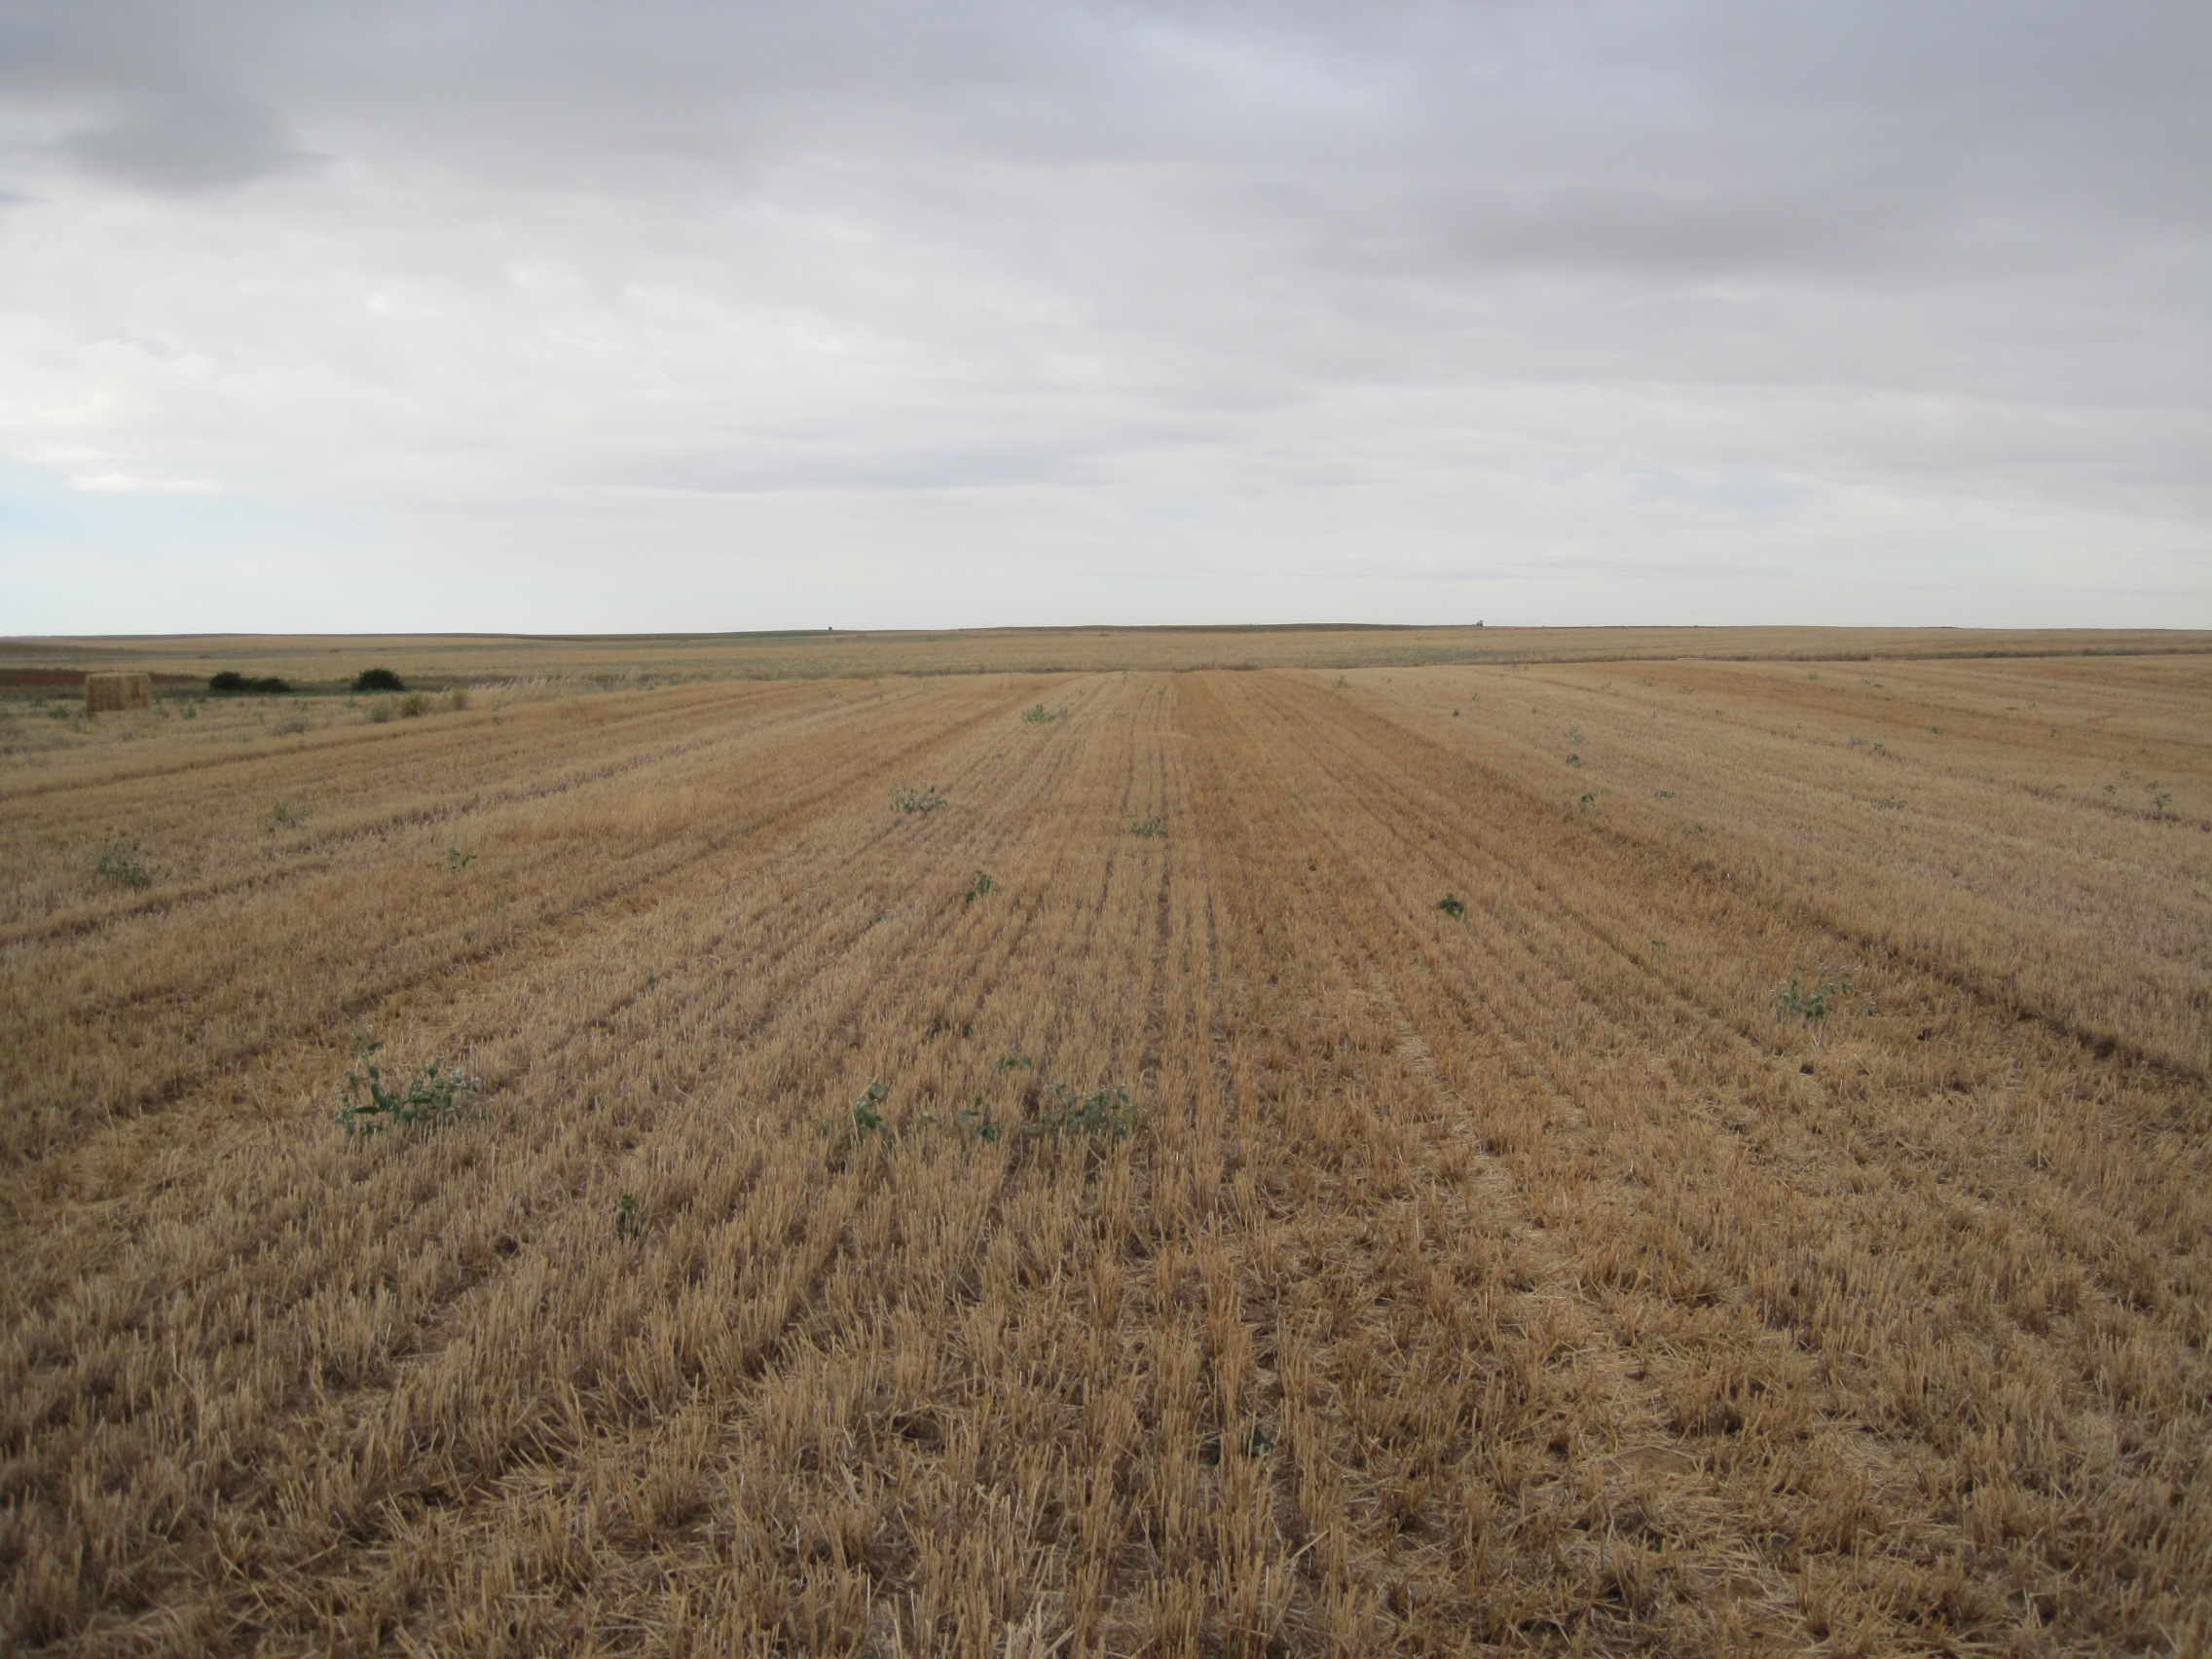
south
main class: Cropland
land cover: Barley
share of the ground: < 10 %
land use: Agriculture (excluding fallow land and kitchen gardens)
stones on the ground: < 10 %
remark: Harvested field
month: July
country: ES
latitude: 41.9743
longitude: -5.4493
